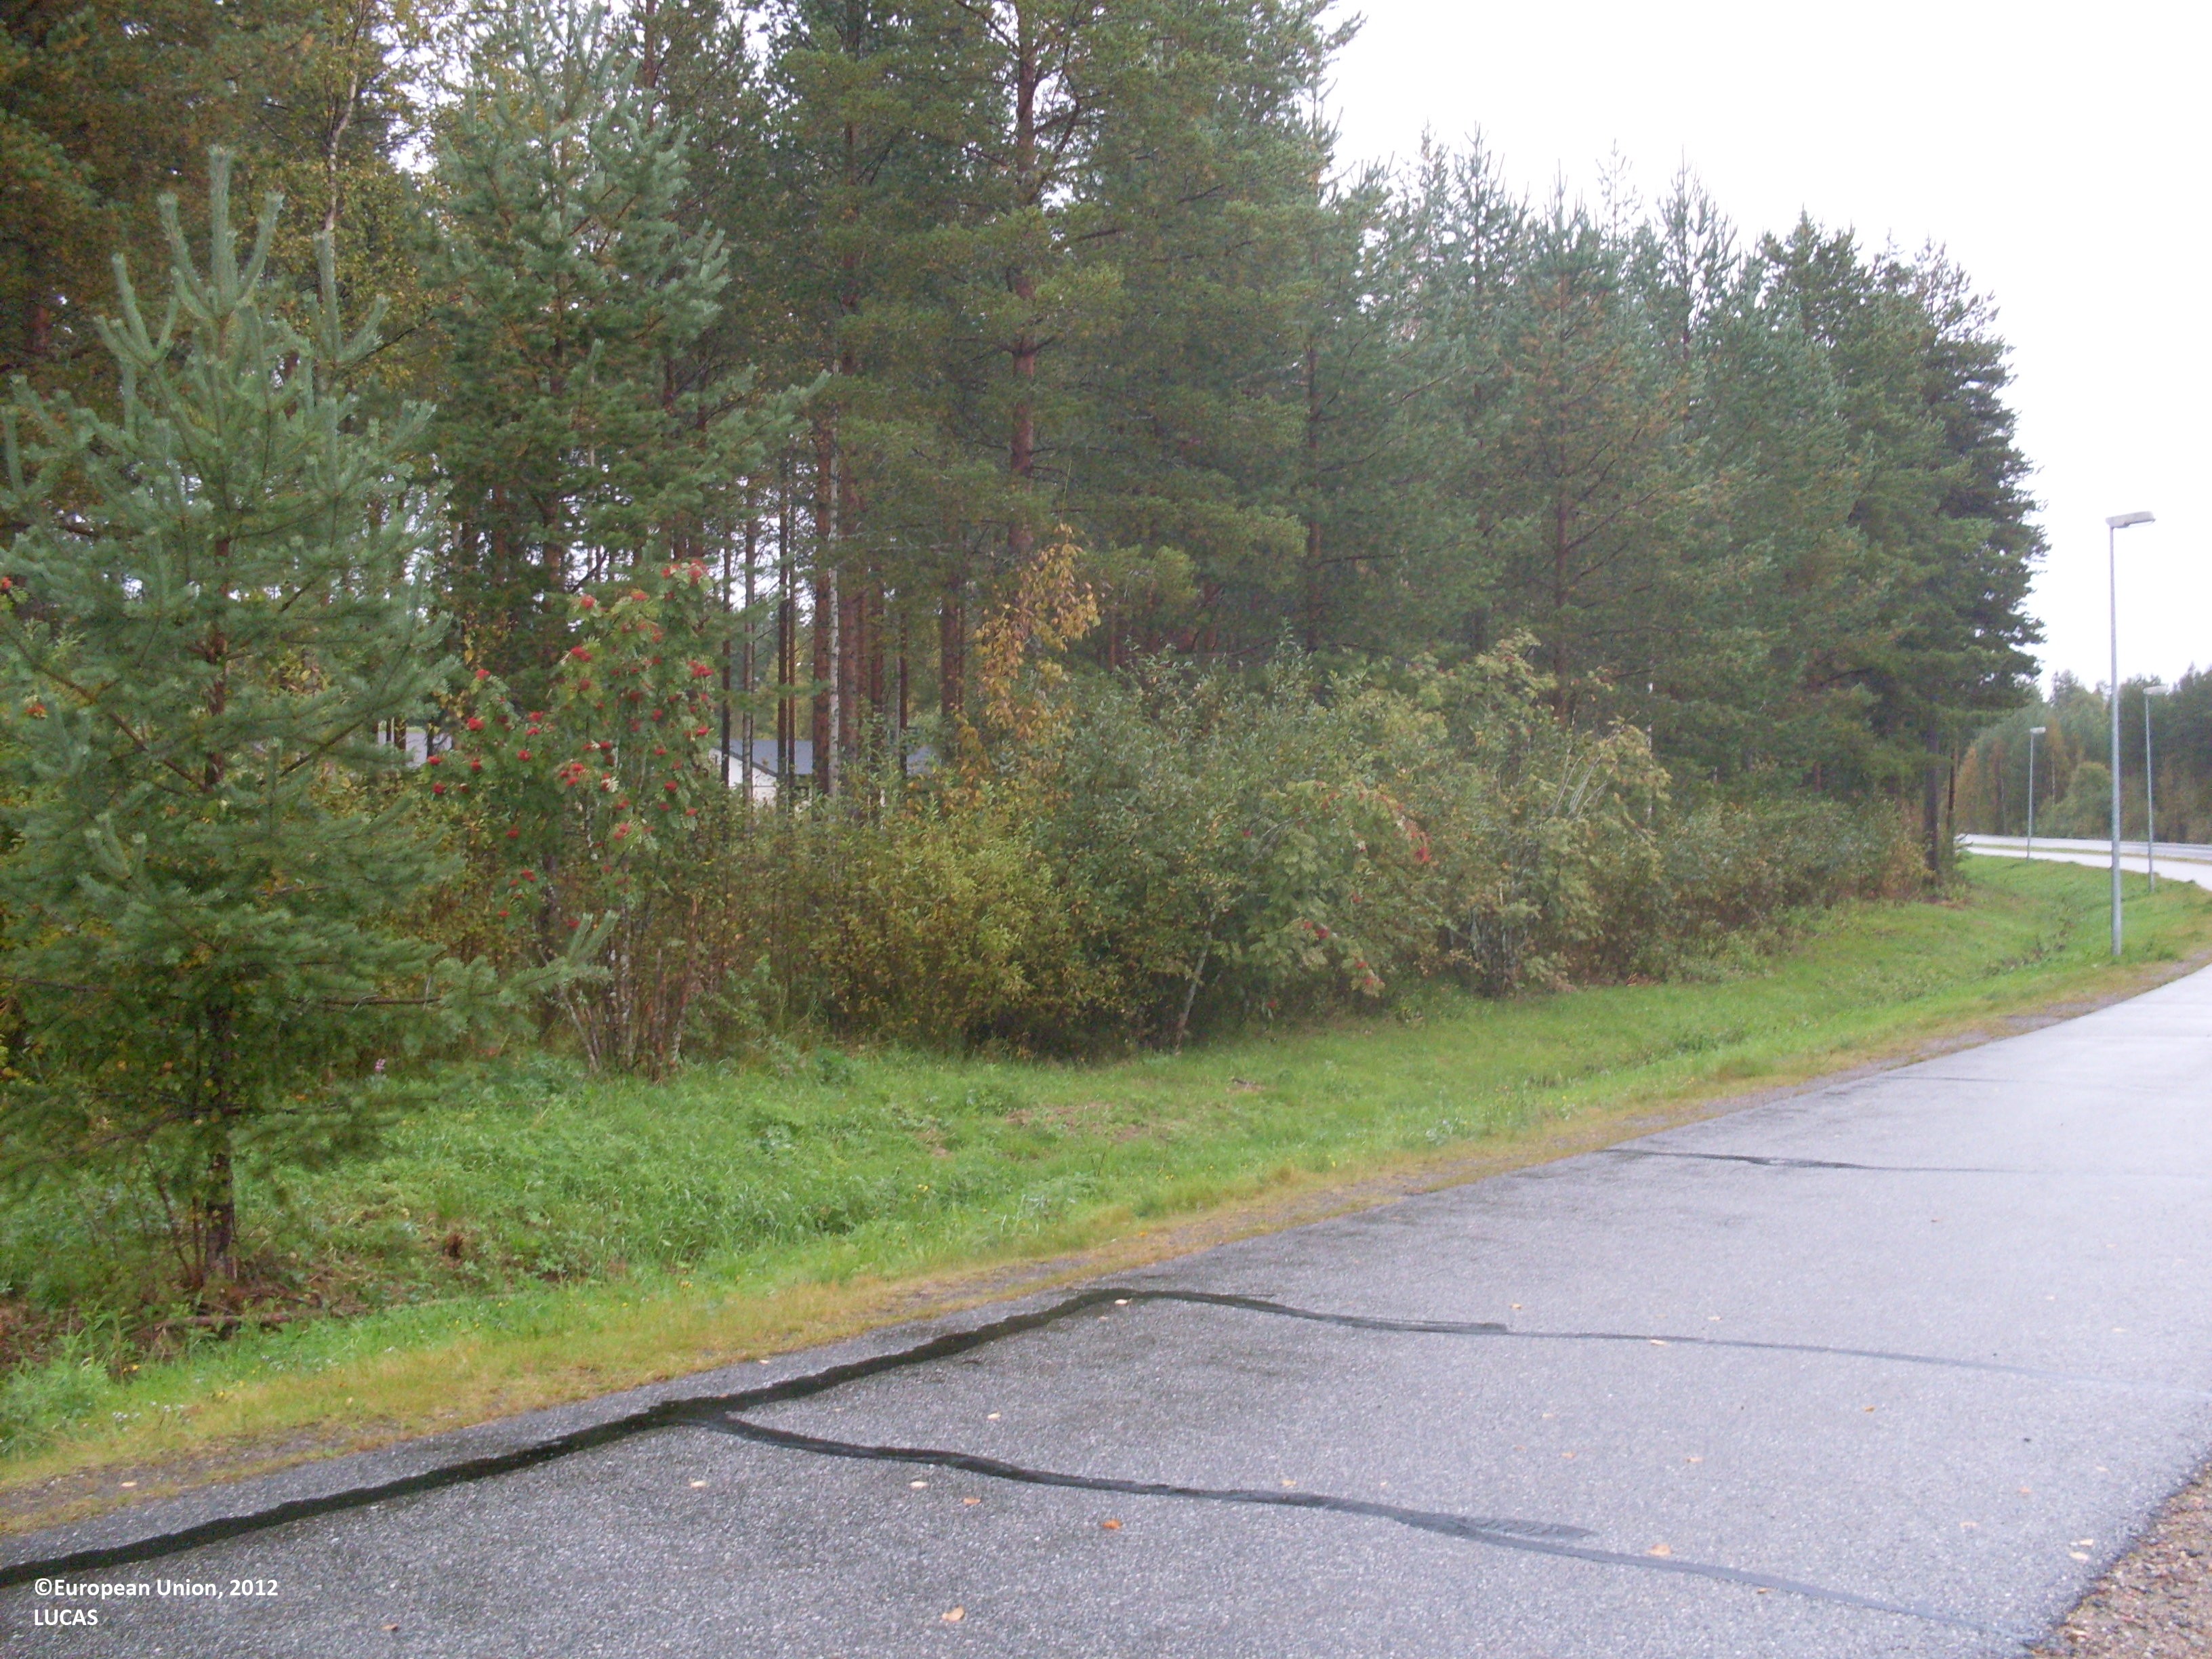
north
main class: Grassland
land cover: Grassland without tree/shrub cover
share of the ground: > 75 %
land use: Road transport
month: September
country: FI
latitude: 64.1183
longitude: 29.5417
